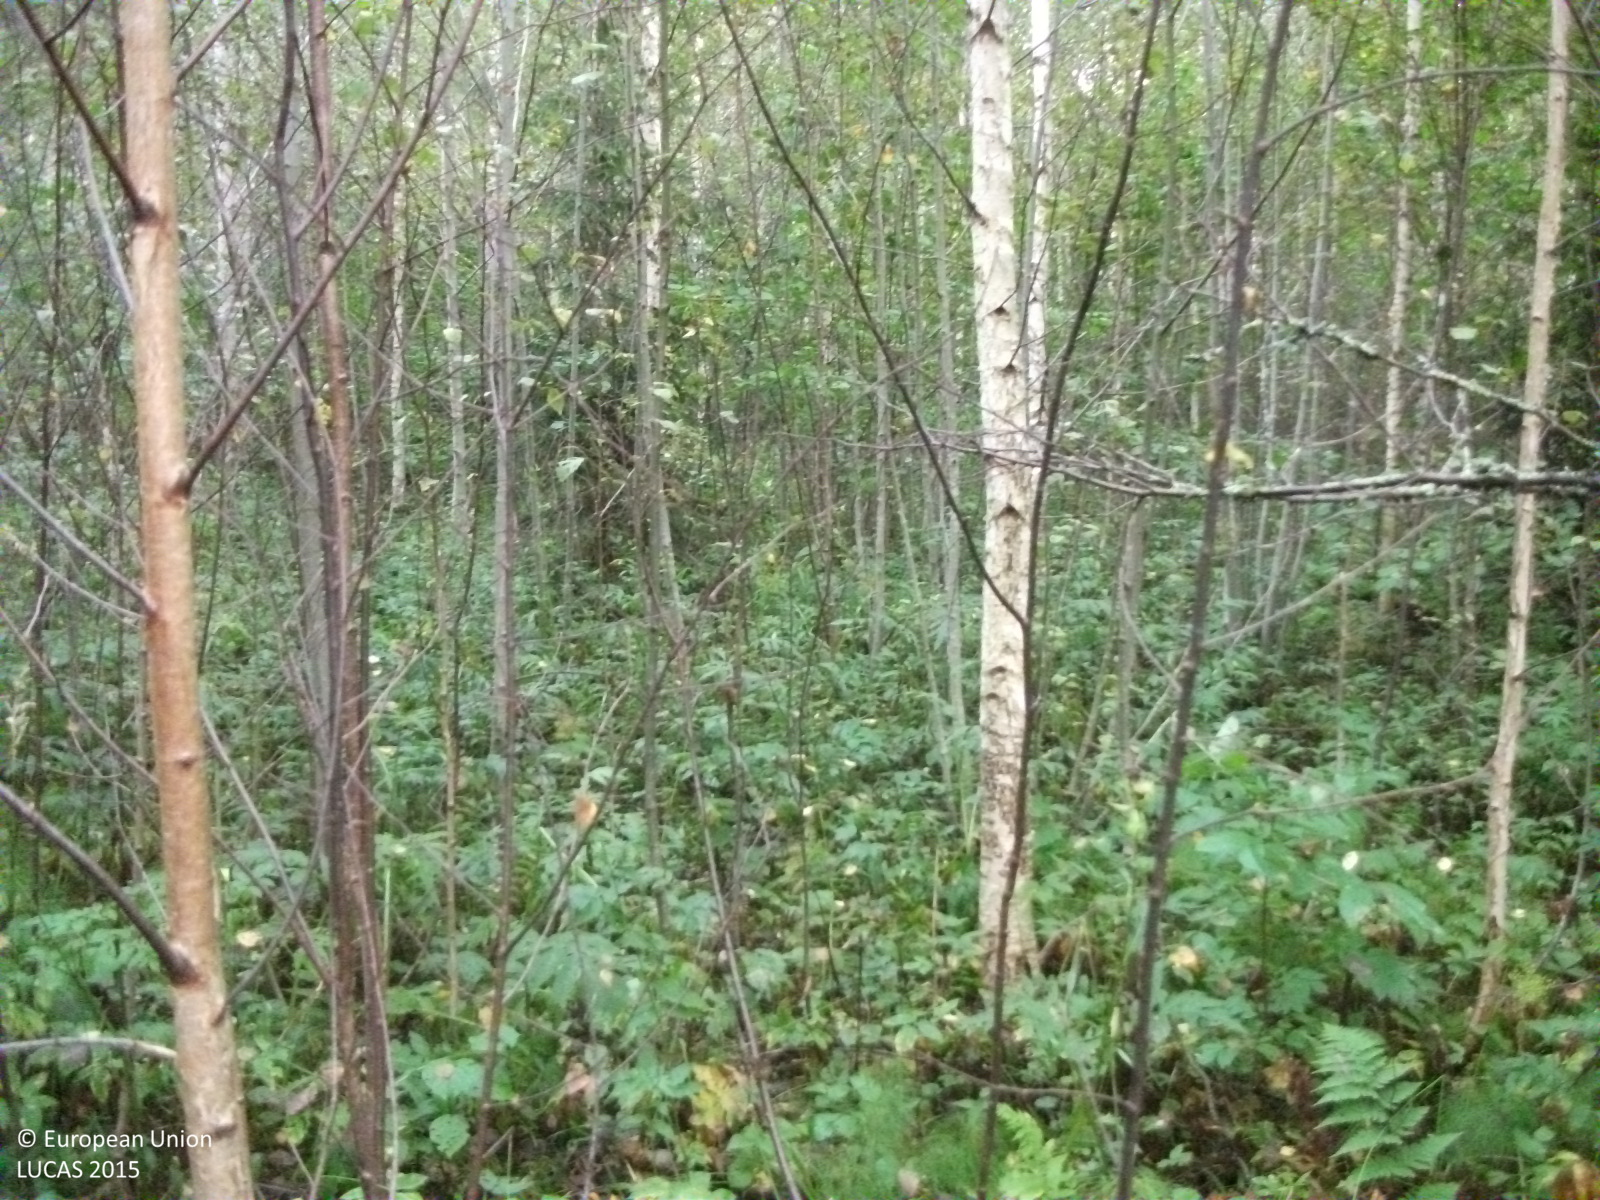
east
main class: Woodland
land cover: Broadleaved woodland
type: non-riverine alder, birch or aspen forest
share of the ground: > 75 %
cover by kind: broadleaved forest trees 80 %, shrubs 10 %, herbaceous plants 10 %
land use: Forestry
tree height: > 5 m
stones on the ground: < 10 %
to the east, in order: Broadleaved woodland; Other mixed woodland; Broadleaved woodland; Ditches and canals; Grass margins; Paved roads, cycling and walking lanes; Grass margins; Ditches and canals; Broadleaved woodland
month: September
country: LV
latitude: 57.6621
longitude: 24.6939
